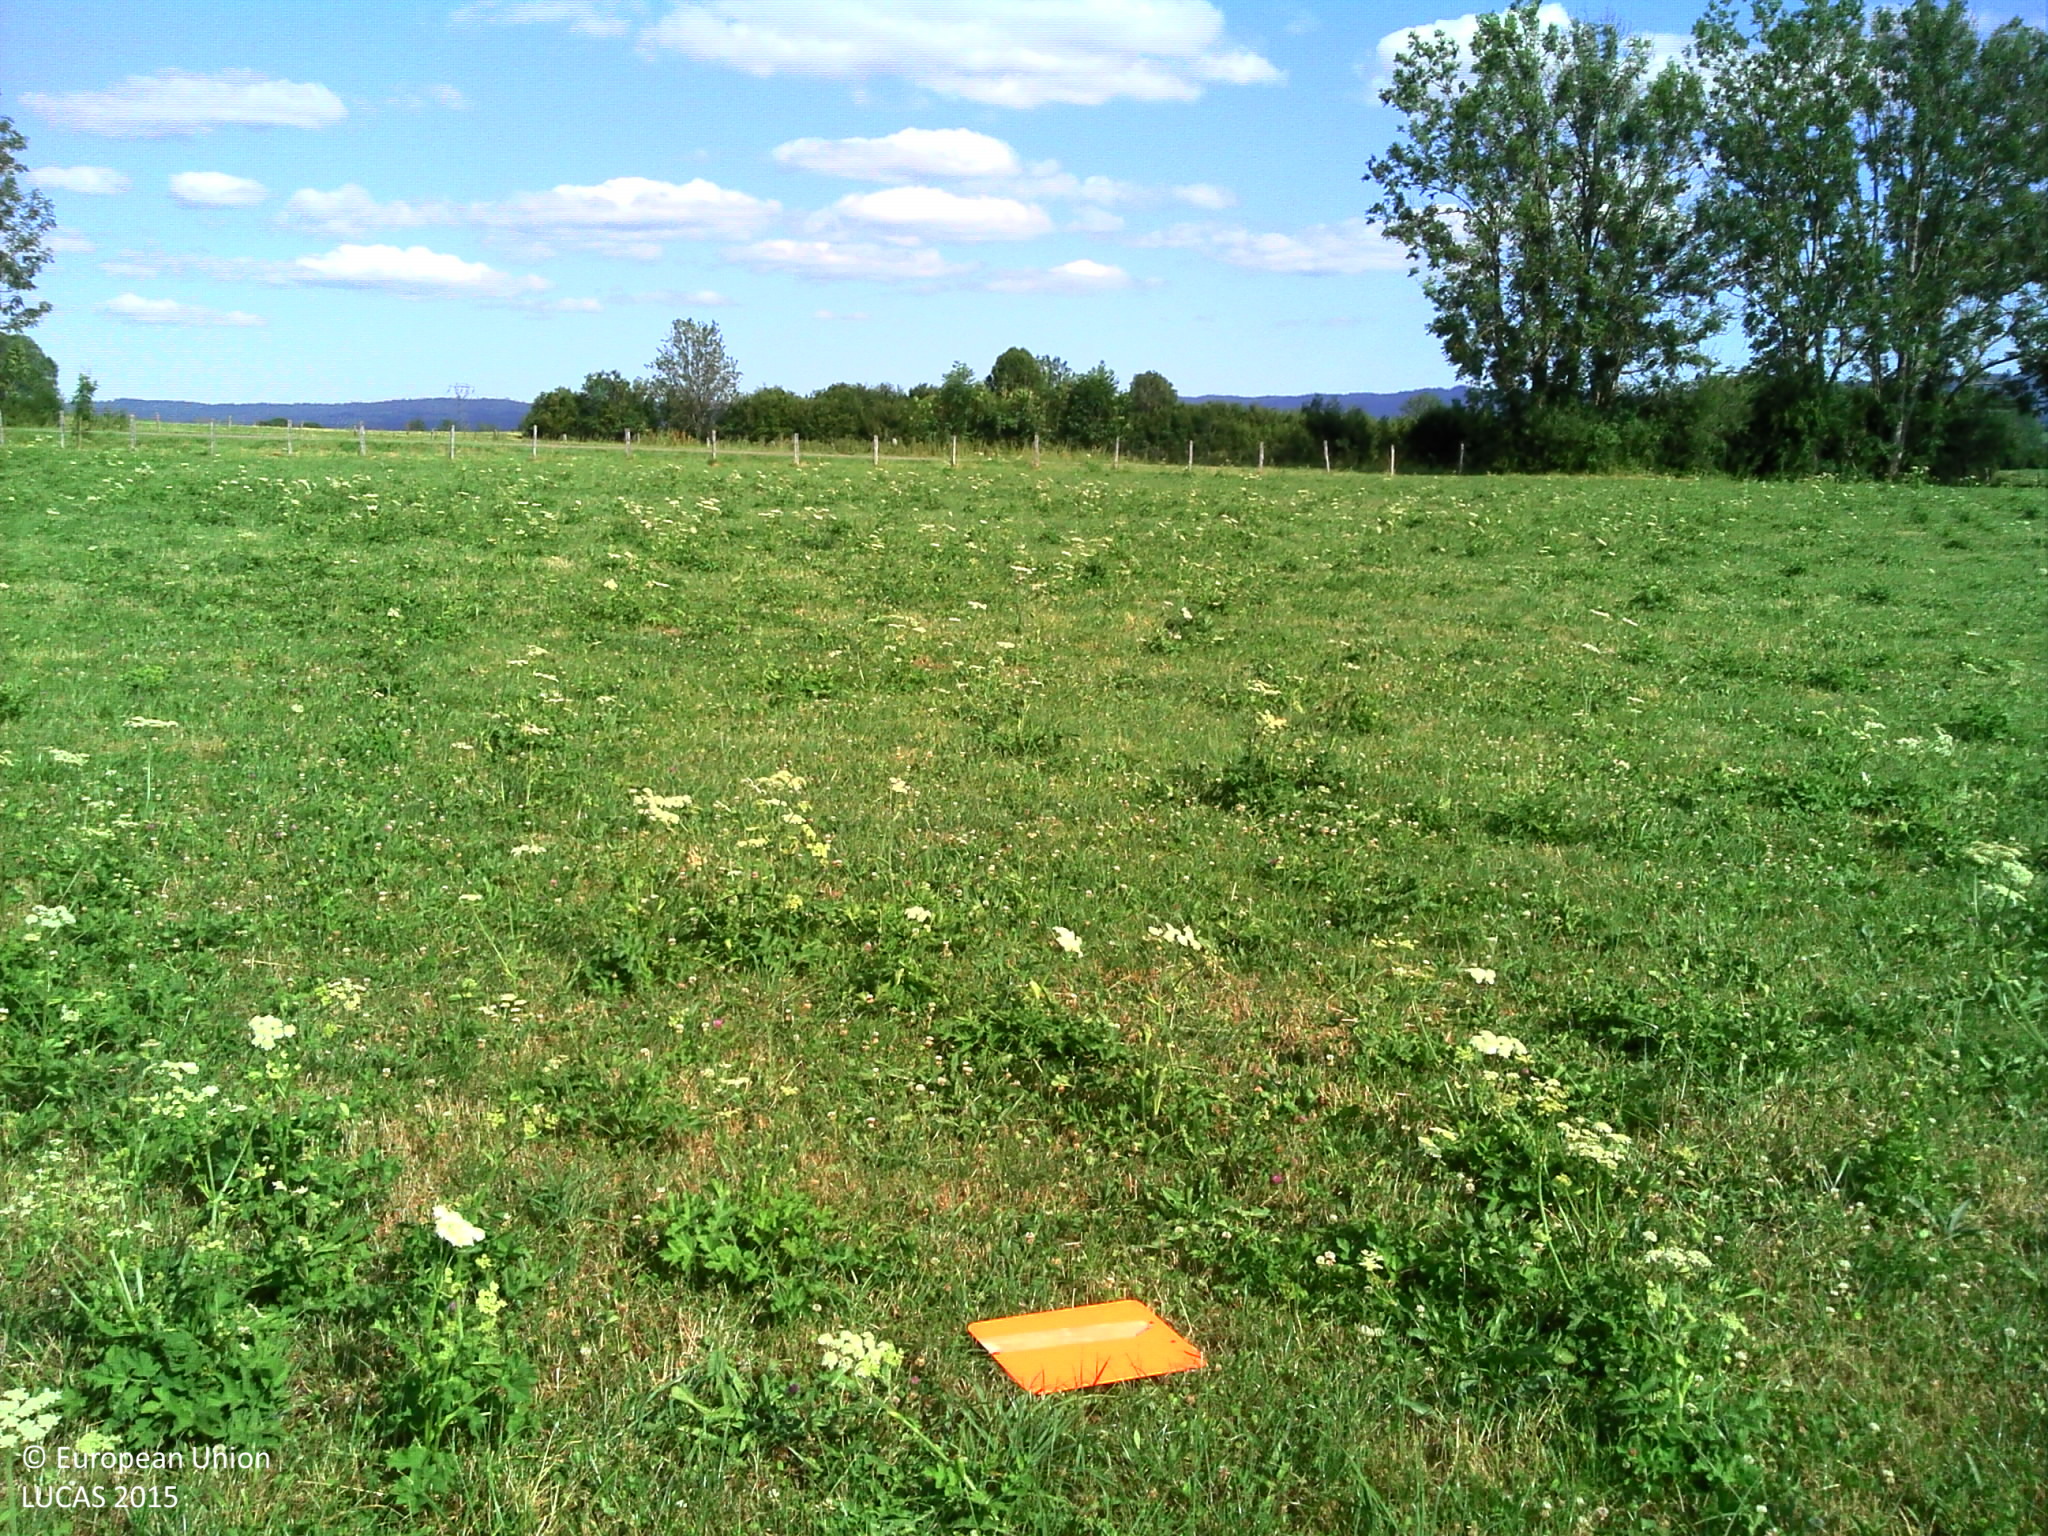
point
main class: Grassland
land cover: Grassland without tree/shrub cover
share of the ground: > 75 %
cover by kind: herbaceous plants 100 %
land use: Agriculture (excluding fallow land and kitchen gardens)
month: July
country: FR
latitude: 46.8015
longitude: 6.0585
